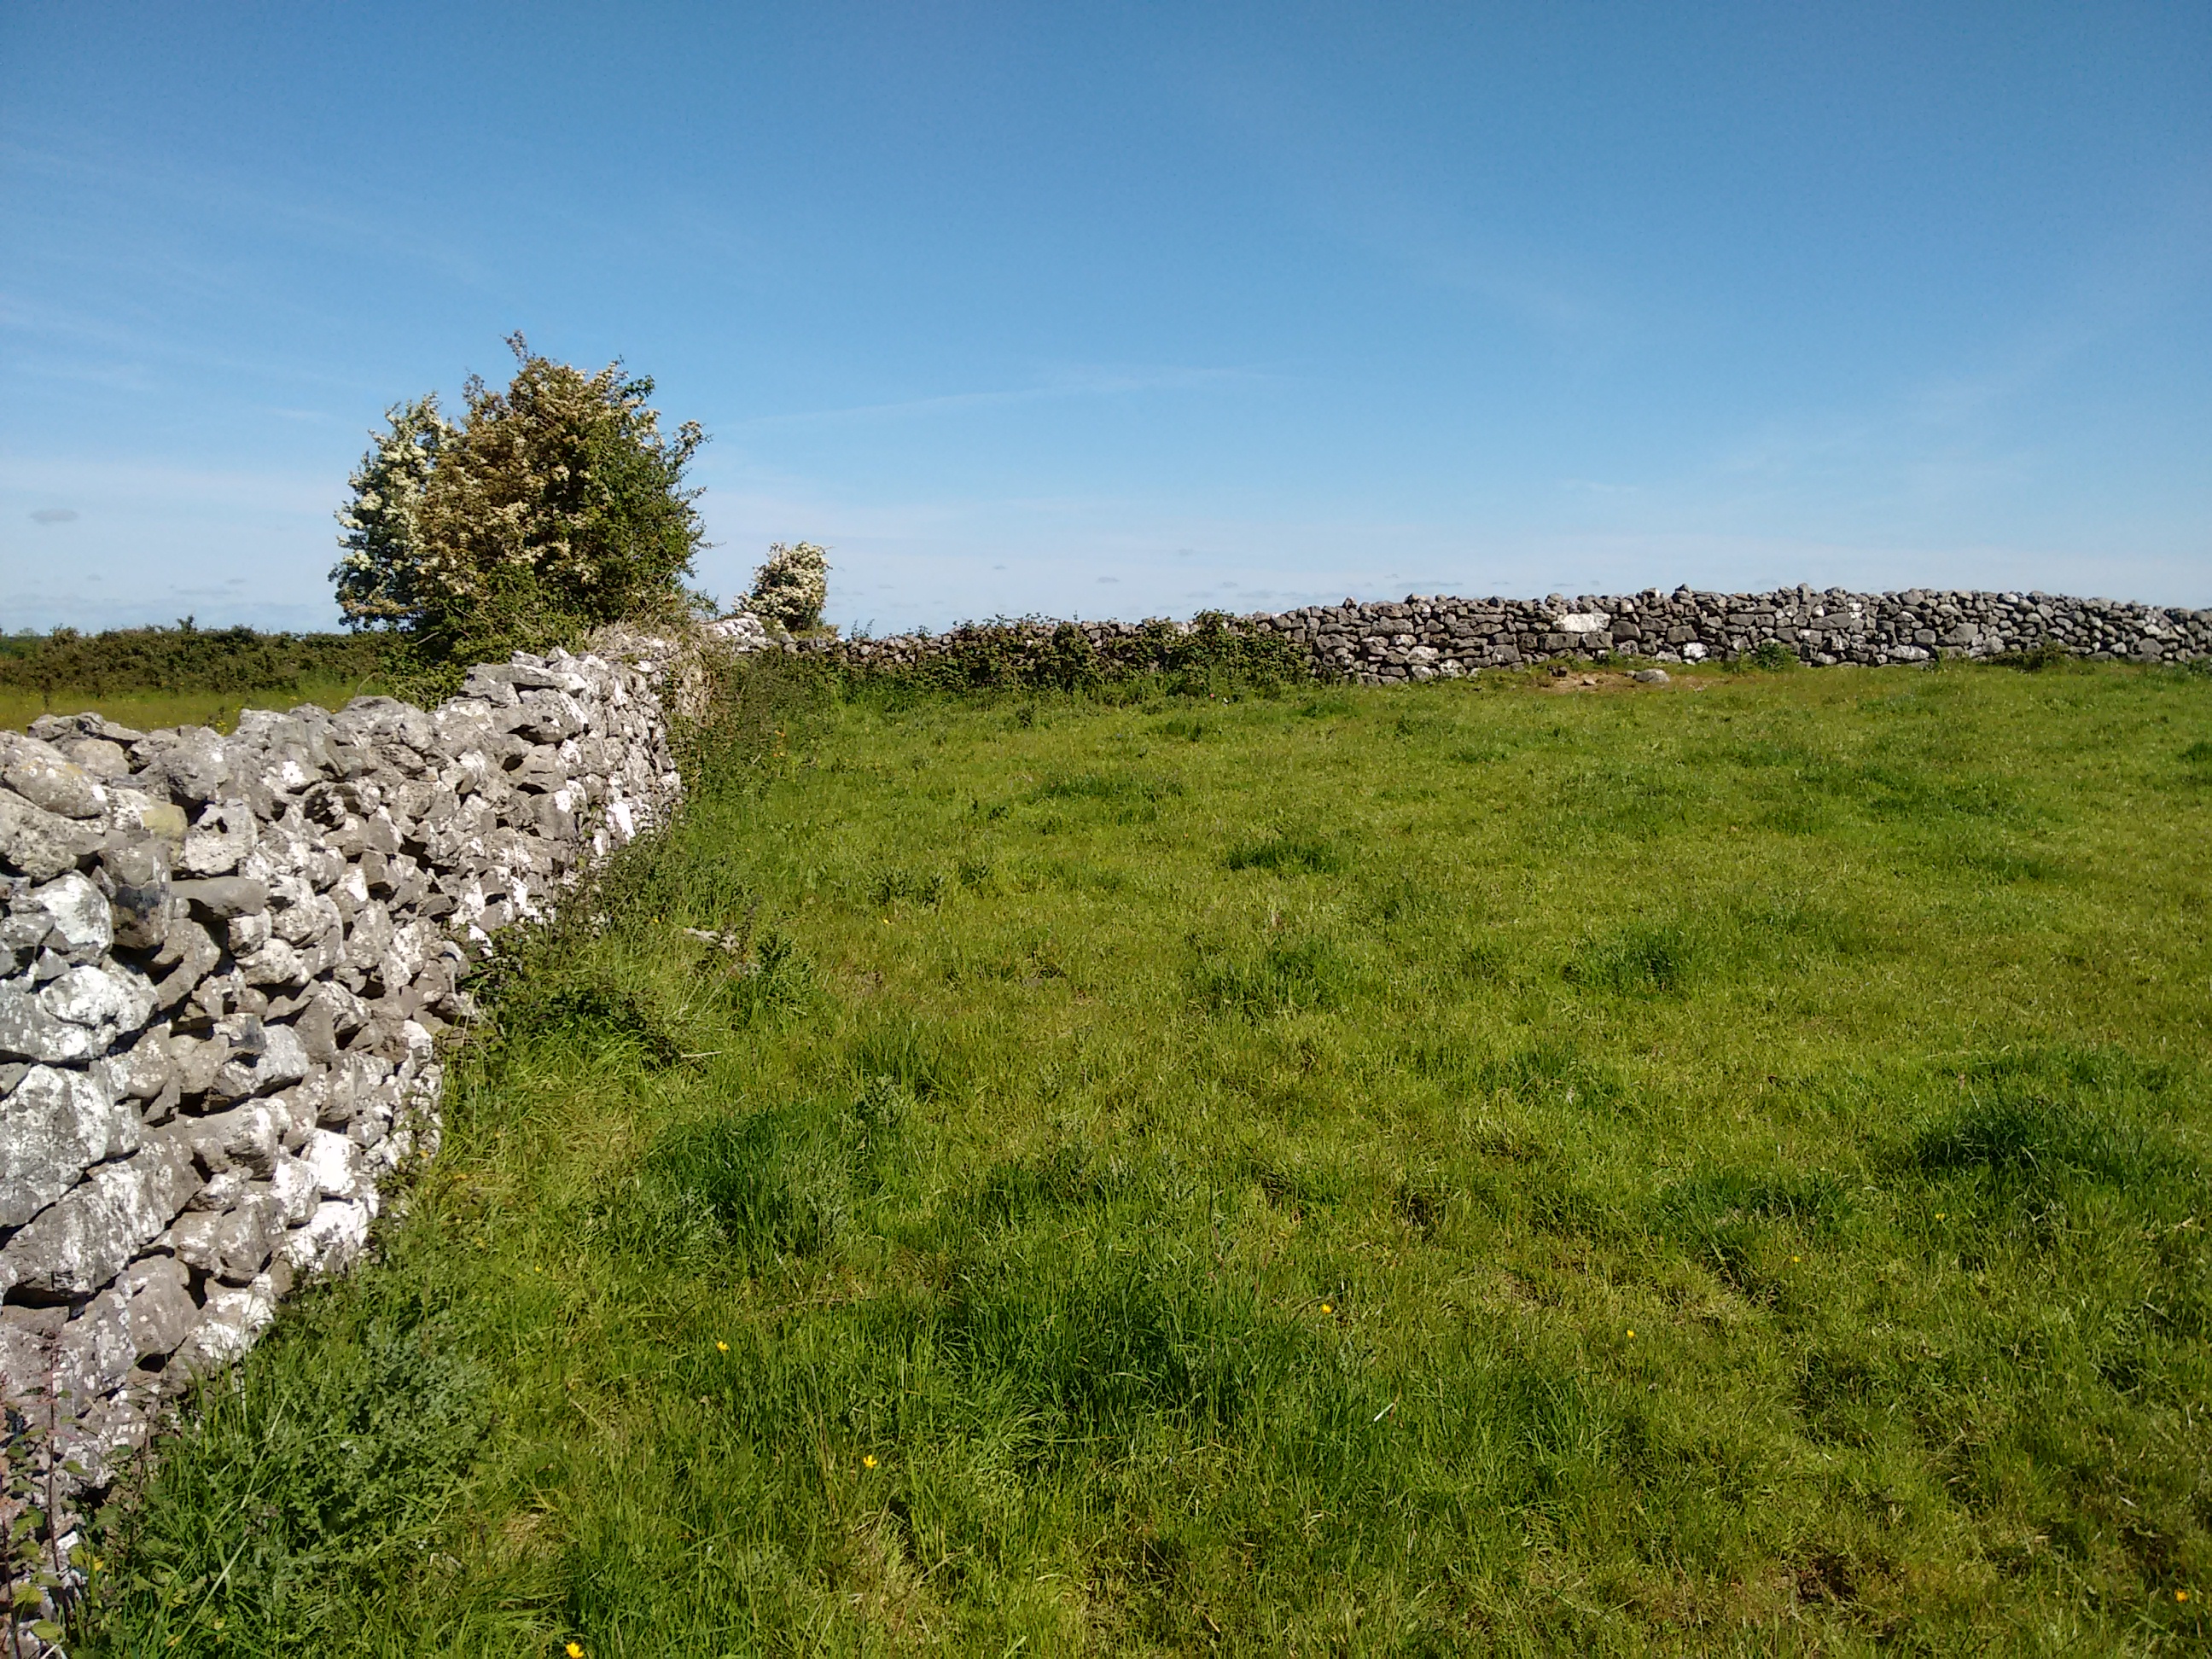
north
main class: Grassland
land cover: Grassland without tree/shrub cover
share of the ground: > 75 %
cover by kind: herbaceous plants 100 %
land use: Agriculture (excluding fallow land and kitchen gardens)
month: June
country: IE
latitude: 53.2167
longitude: -8.6026
